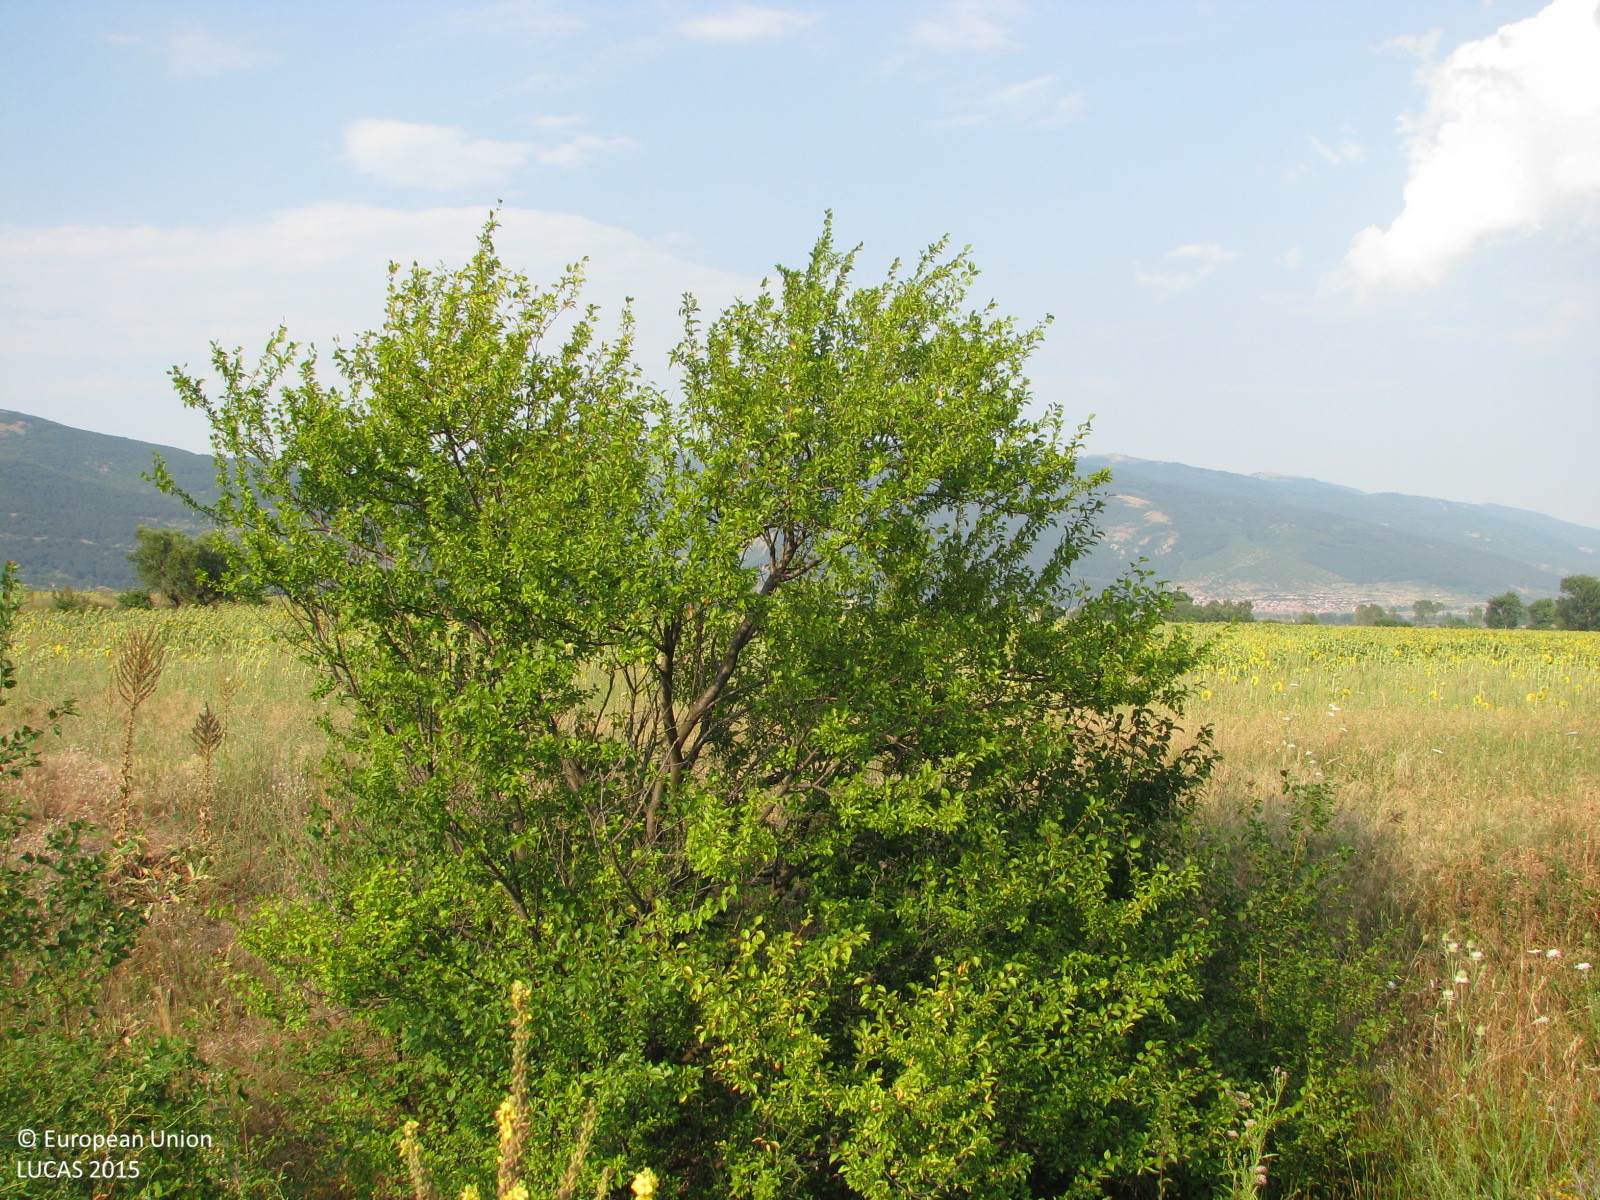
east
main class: Cropland
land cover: Common wheat
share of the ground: > 75 %
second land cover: Spontaneously vegetated surfaces
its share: 10 - 25 %
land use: Agriculture (excluding fallow land and kitchen gardens)
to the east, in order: Common wheat; Spontaneously vegetated surfaces; Grass margins; Single bushes/trees; Ditches and canals; Grass margins; Tracks; Sunflower
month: July
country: BG
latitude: 42.6809
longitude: 25.8594
